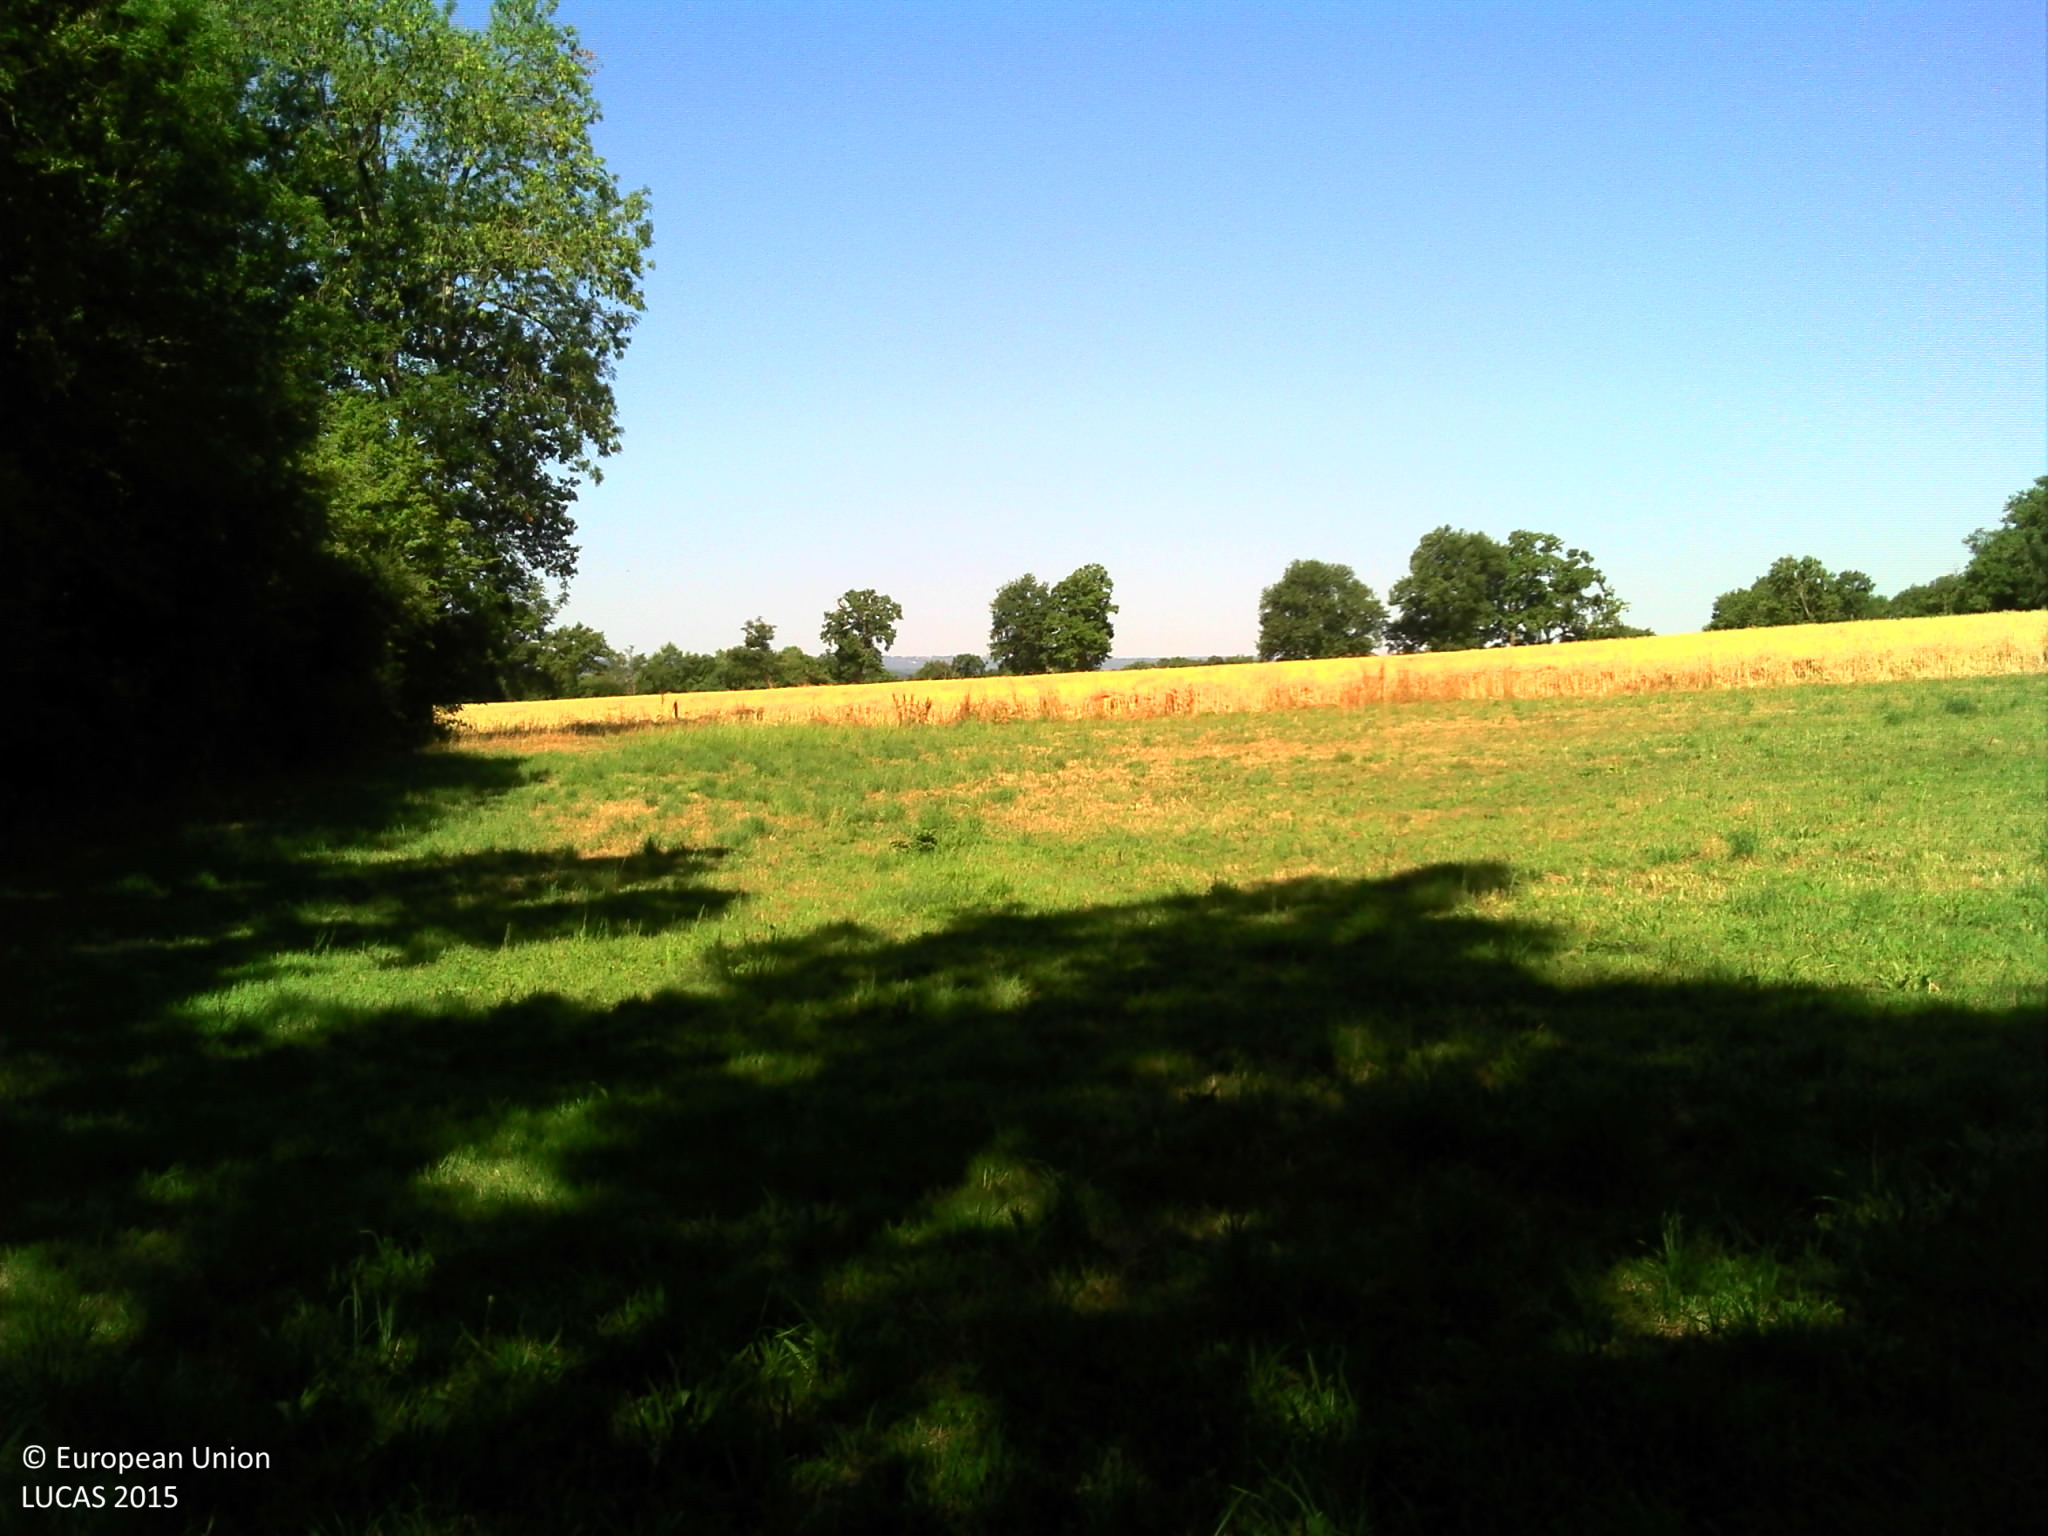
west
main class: Grassland
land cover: Grassland without tree/shrub cover
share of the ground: > 75 %
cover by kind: herbaceous plants 95 %
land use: Agriculture (excluding fallow land and kitchen gardens)
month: July
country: FR
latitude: 45.7754
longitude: 1.2587
